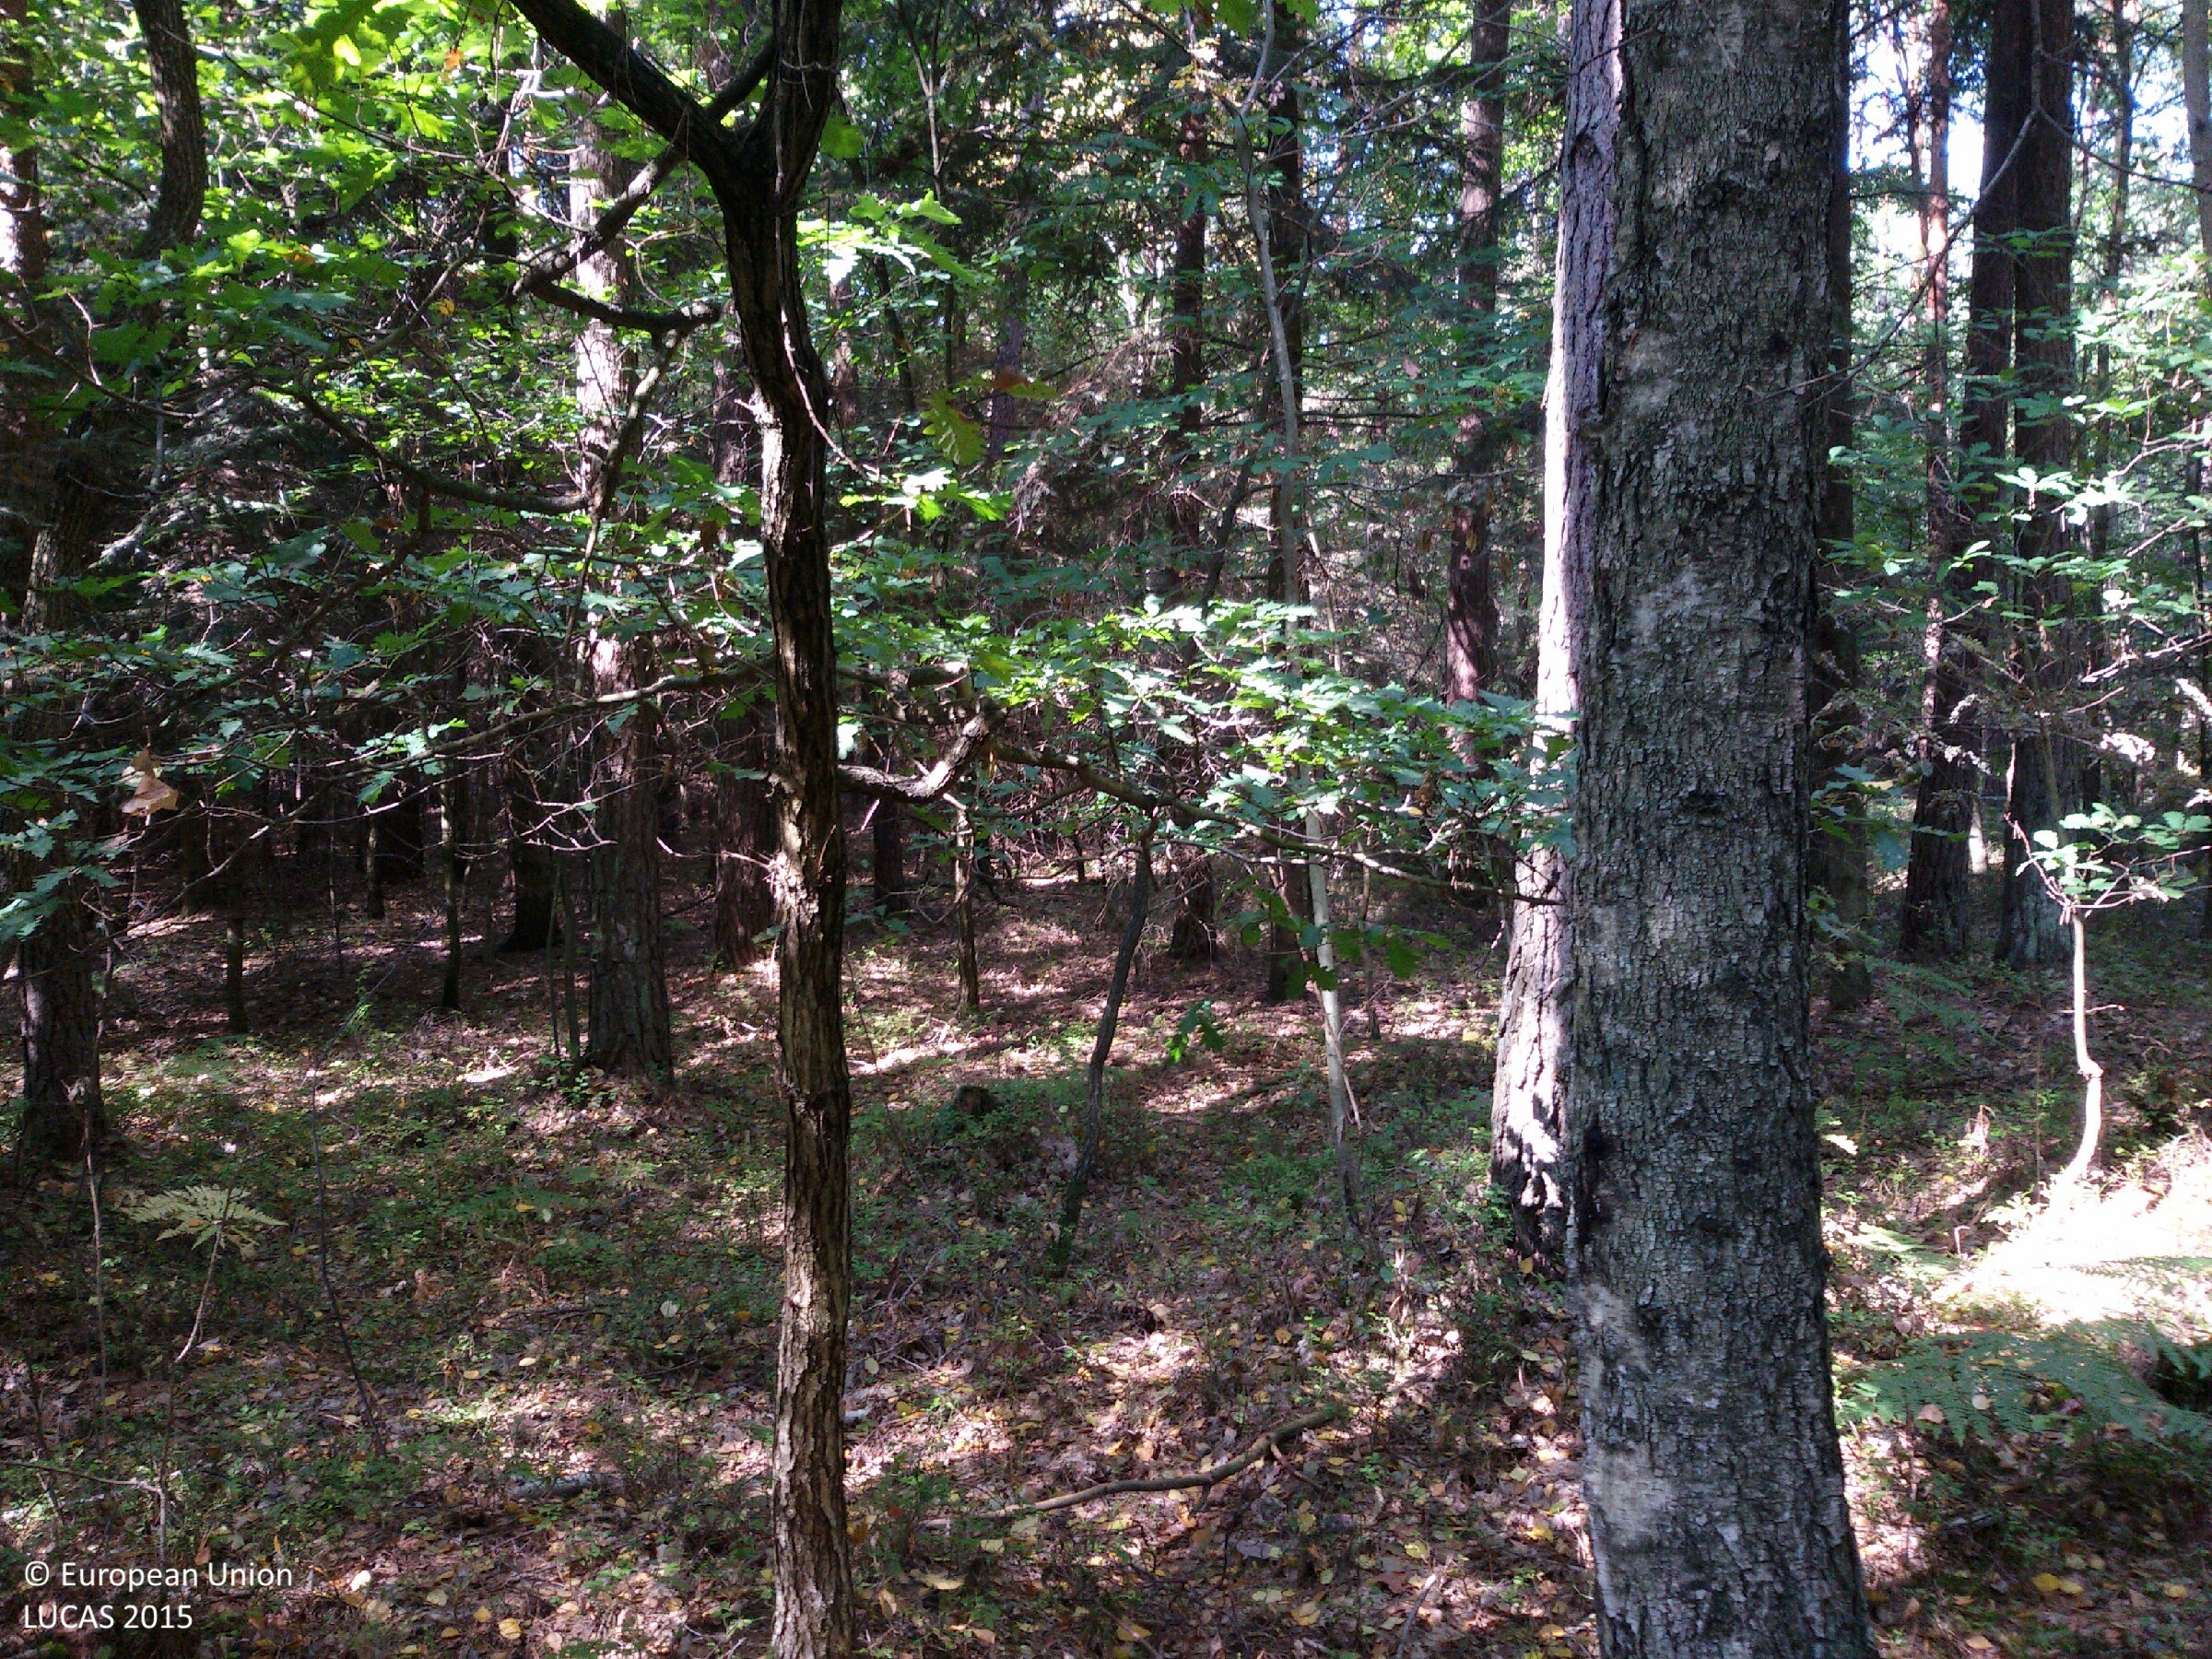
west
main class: Woodland
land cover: Pine dominated mixed woodland
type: hemiboreal forest and nemoral coniferous forest and mixed broadleaved-coniferous forest
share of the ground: > 75 %
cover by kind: coniferous forest trees 60 %, broadleaved forest trees 25 %, herbaceous plants 10 %, shrubs 5 %
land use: Forestry
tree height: > 5 m
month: August
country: PL
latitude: 50.7502
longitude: 20.8856
